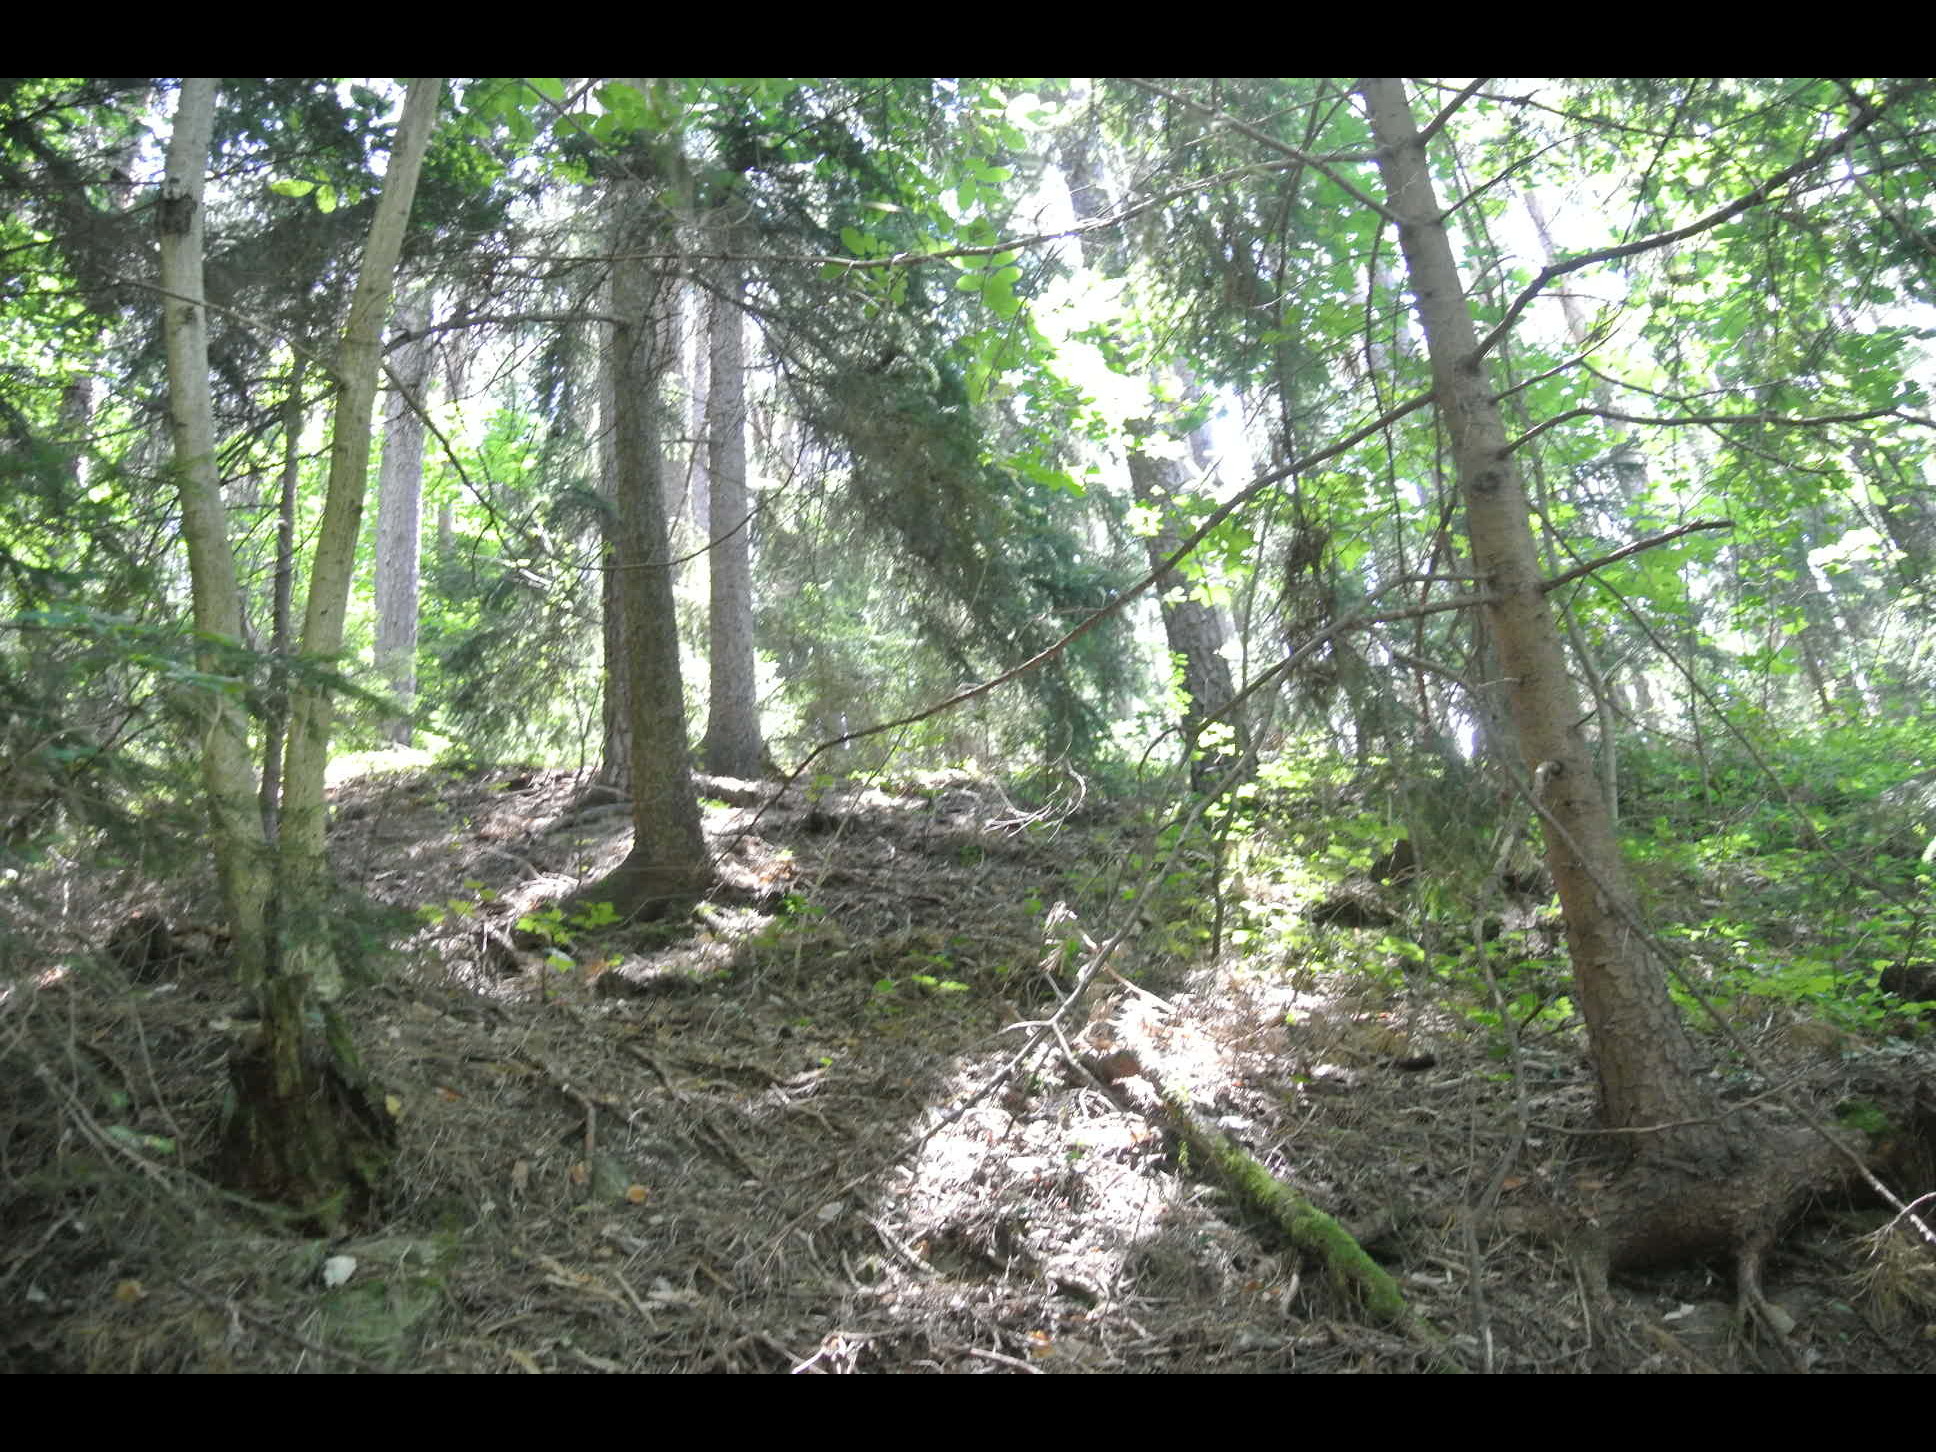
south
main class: Woodland
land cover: Other mixed woodland
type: alpine coniferous forest
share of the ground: > 75 %
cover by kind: coniferous forest trees 70 %, broadleaved forest trees 30 %
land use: Forestry
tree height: > 5 m
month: July
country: AT
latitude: 47.6806
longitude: 16.0103
